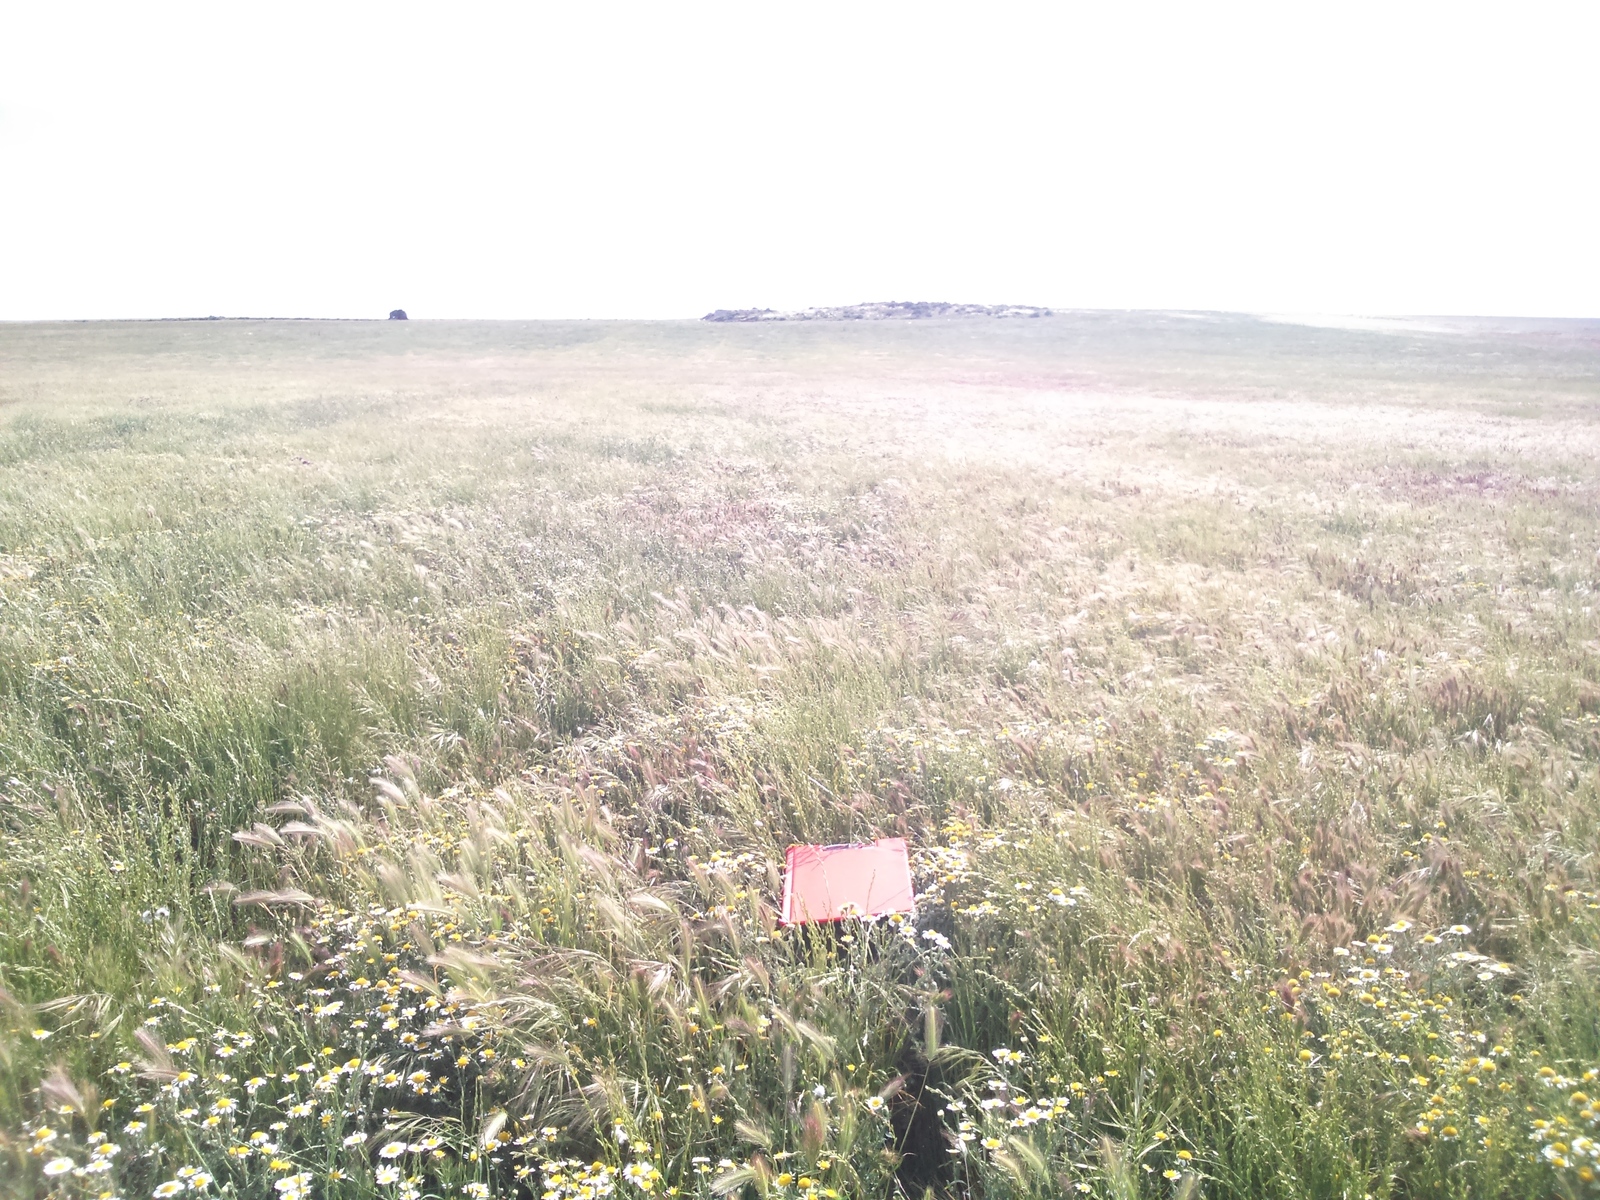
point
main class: Grassland
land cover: Spontaneously vegetated surfaces
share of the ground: > 75 %
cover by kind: herbaceous plants 100 %
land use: Fallow land
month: April
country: ES
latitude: 41.4641
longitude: -0.2044
